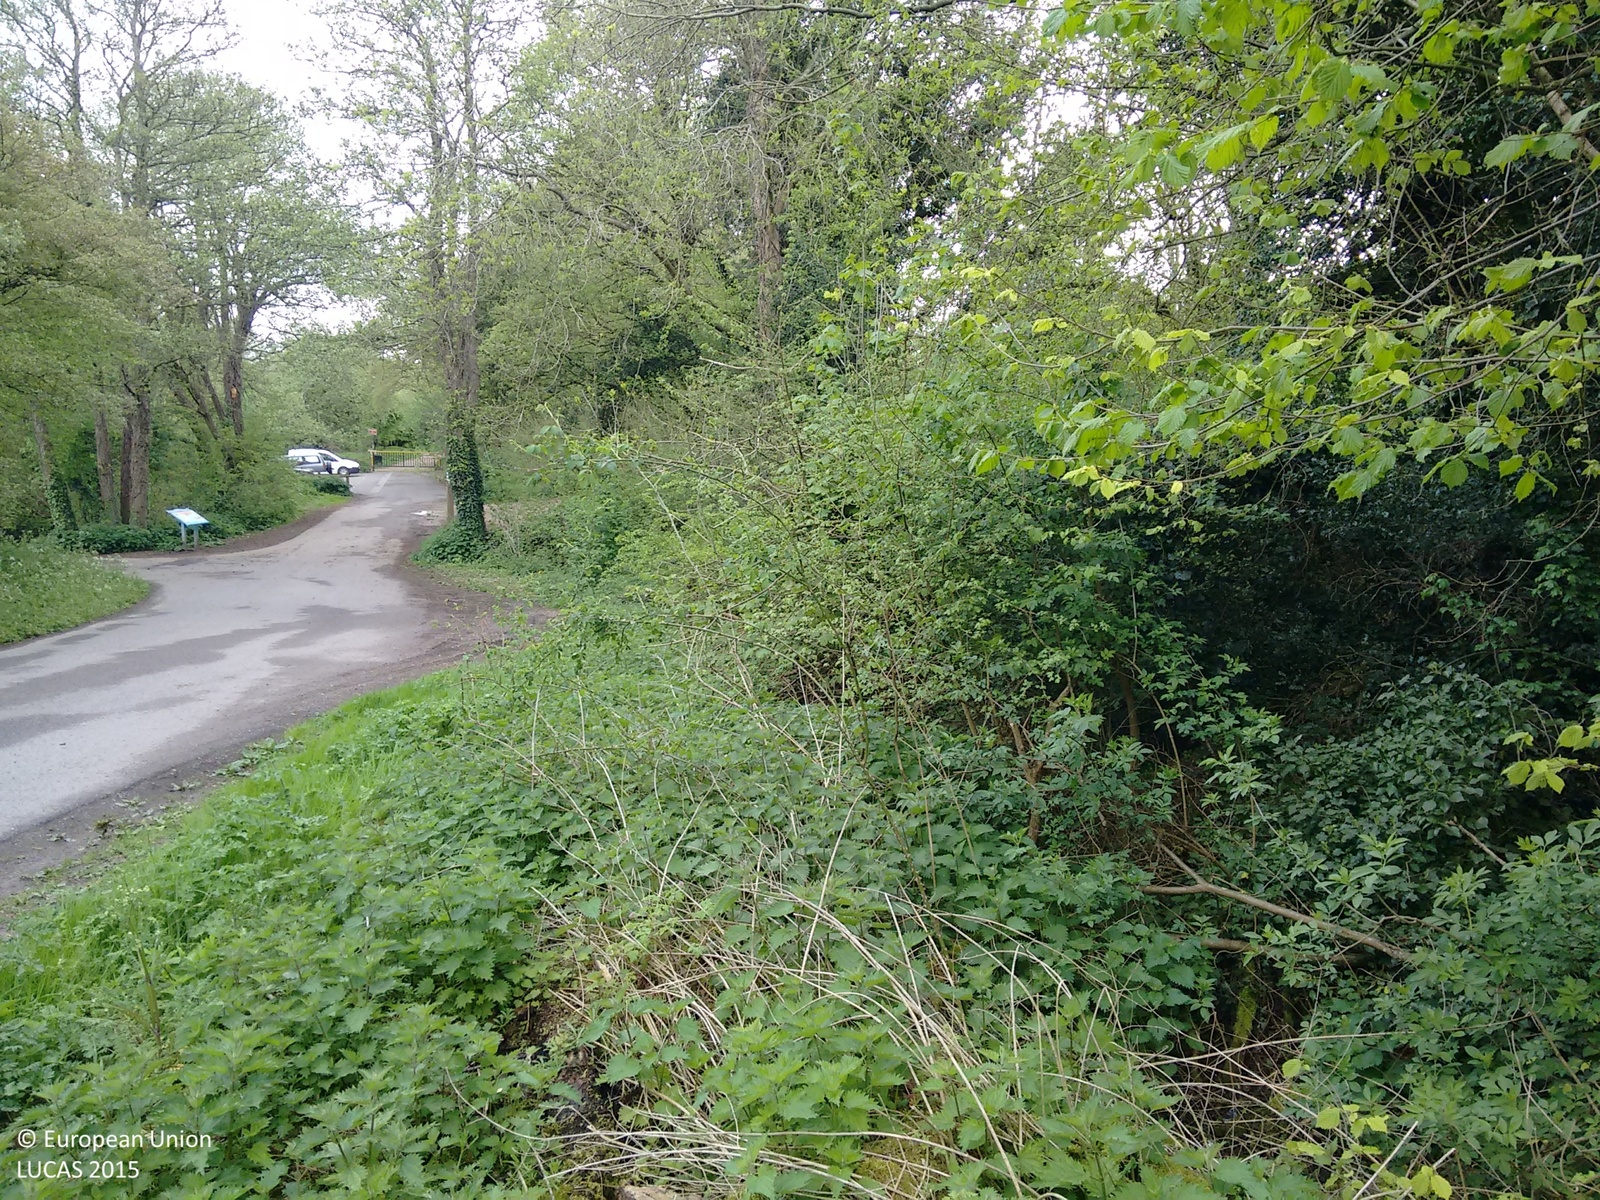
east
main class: Woodland
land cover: Broadleaved woodland
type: mesophytic deciduous forest
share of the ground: > 75 %
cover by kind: broadleaved forest trees 100 %
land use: Amenities, museums, leisure
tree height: > 5 m
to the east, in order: Broadleaved woodland; Fences; Grassland with sparse tree/shrub cover; Grassland without tree/shrub cover; Electric lines; Grassland without tree/shrub cover; Broadleaved woodland; Grassland without tree/shrub cover; Broadleaved woodland
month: May
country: GB
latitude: 51.2179
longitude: -1.4903
